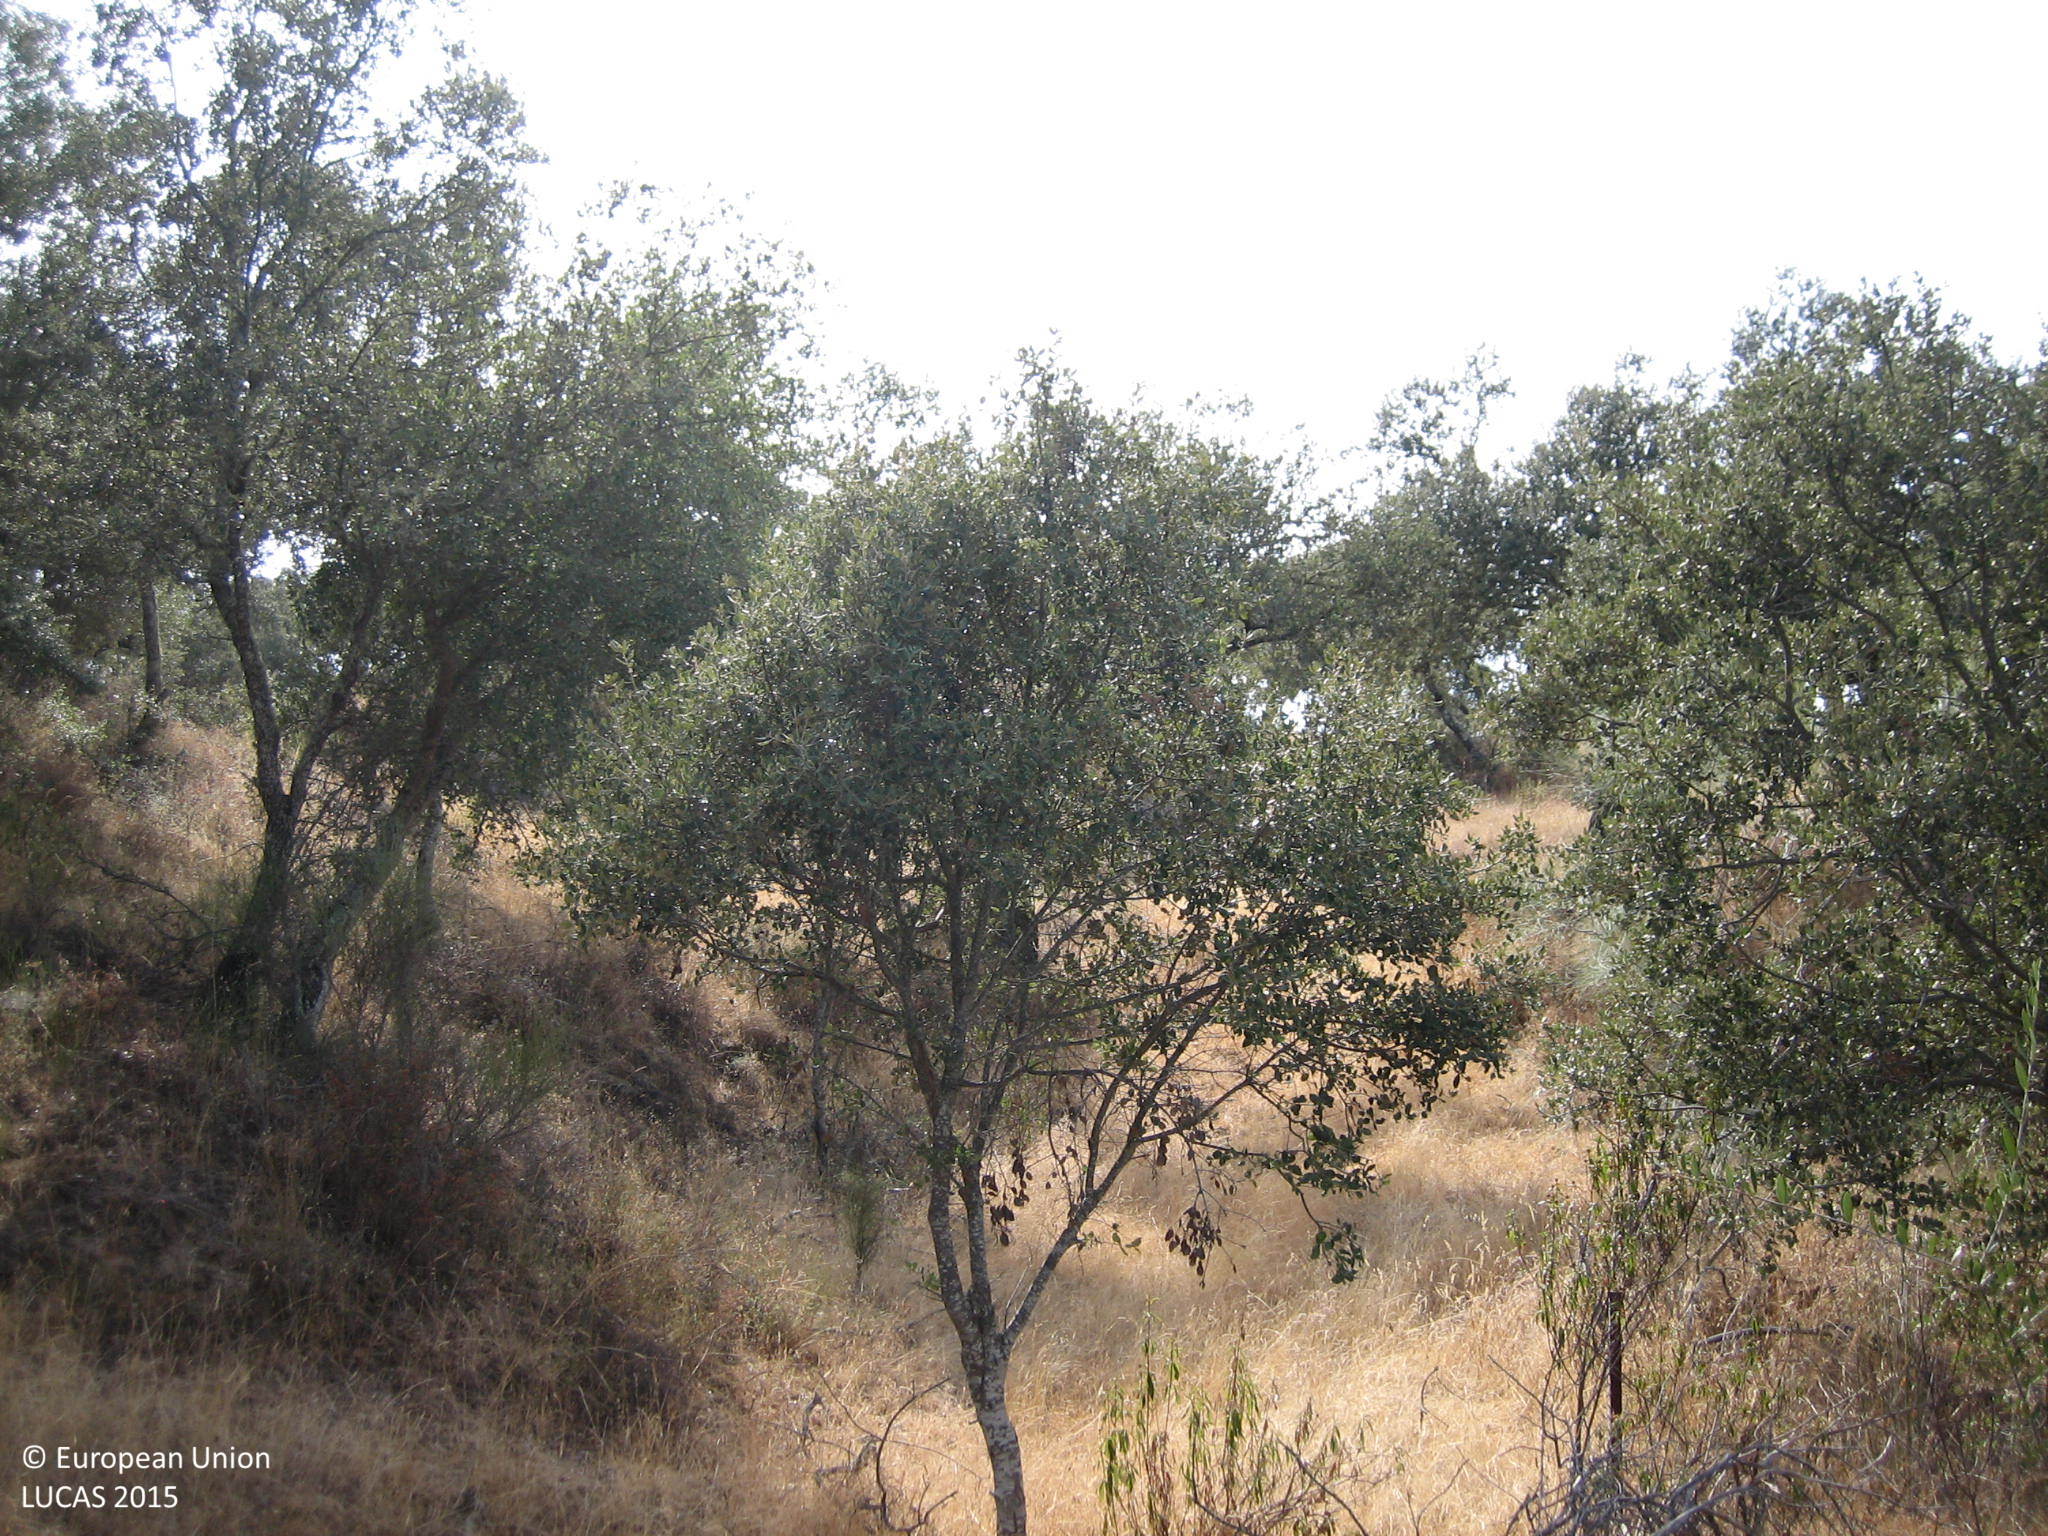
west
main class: Woodland
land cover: Broadleaved woodland
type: broadleaved evergreen forest
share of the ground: 50 - 75 %
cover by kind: broadleaved forest trees 50 %, shrubs 30 %, herbaceous plants 20 %
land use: Forestry
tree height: > 5 m
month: September
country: ES
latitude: 38.2014
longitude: -6.7827
